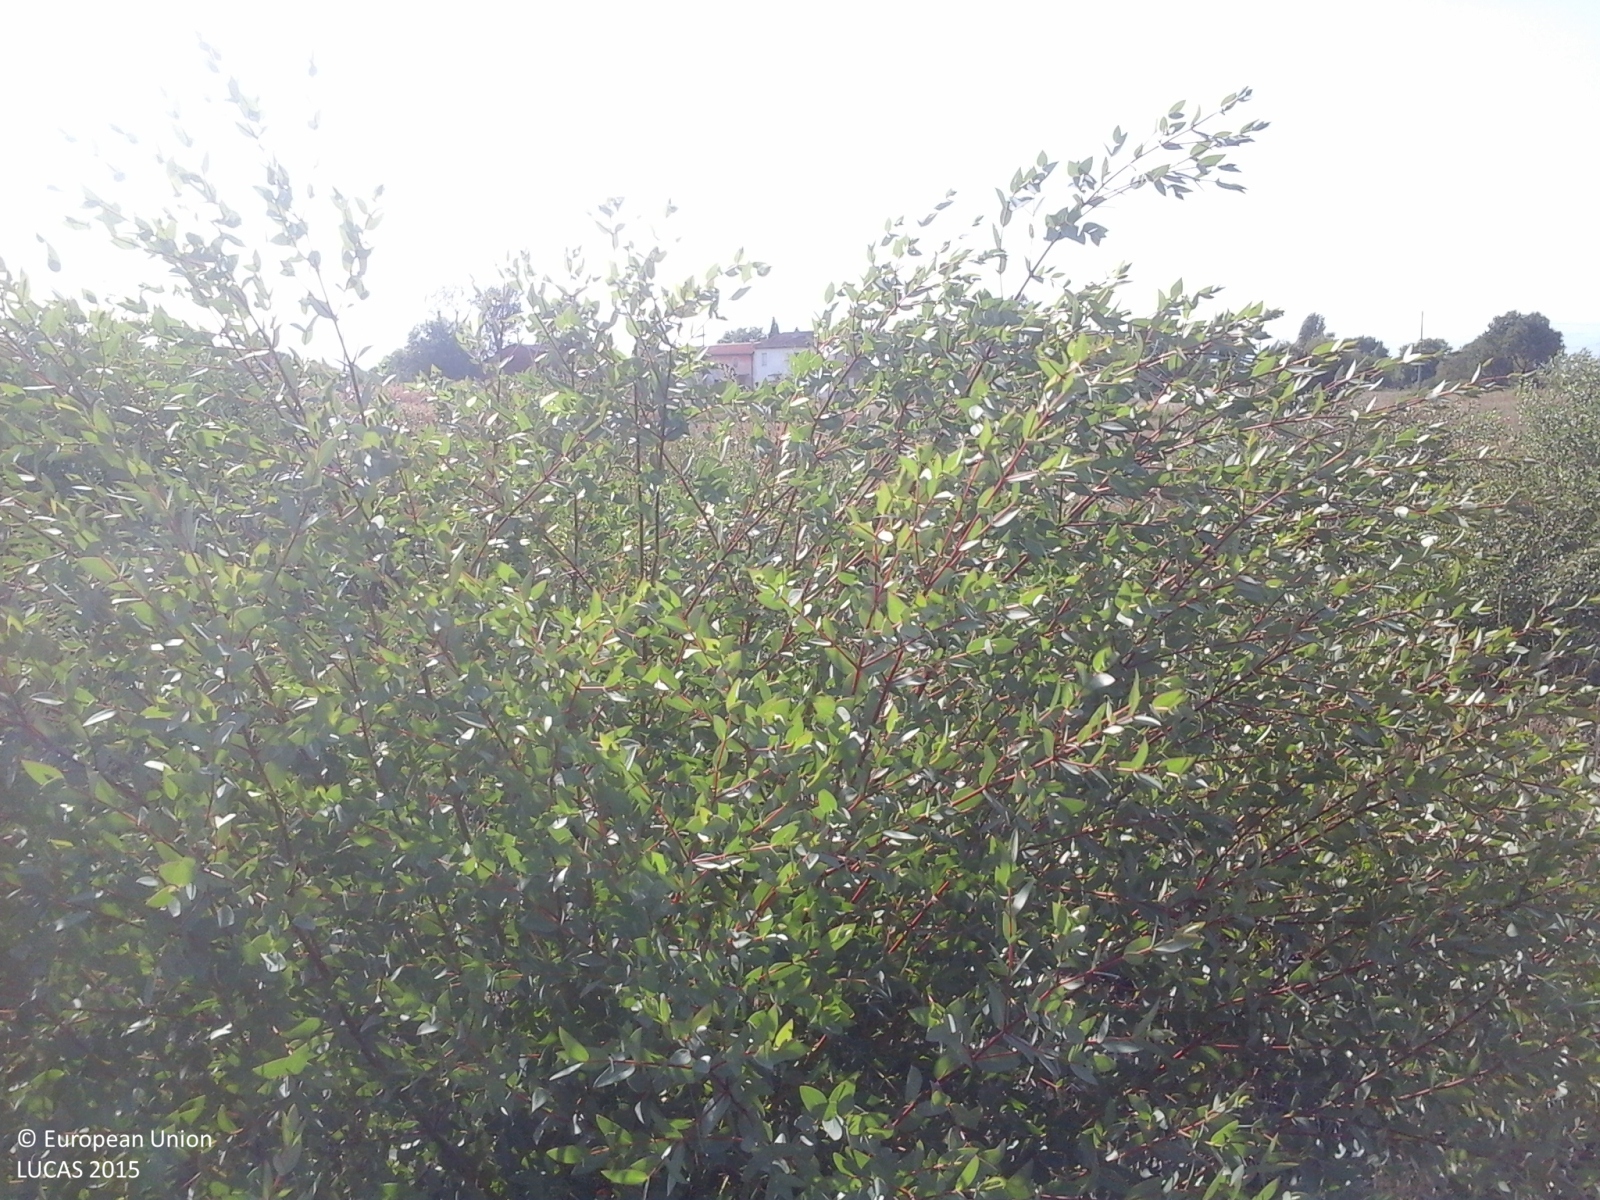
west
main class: Cropland
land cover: Nurseries
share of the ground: > 75 %
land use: Agriculture (excluding fallow land and kitchen gardens)
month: August
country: IT
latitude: 43.8069
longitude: 10.7067
